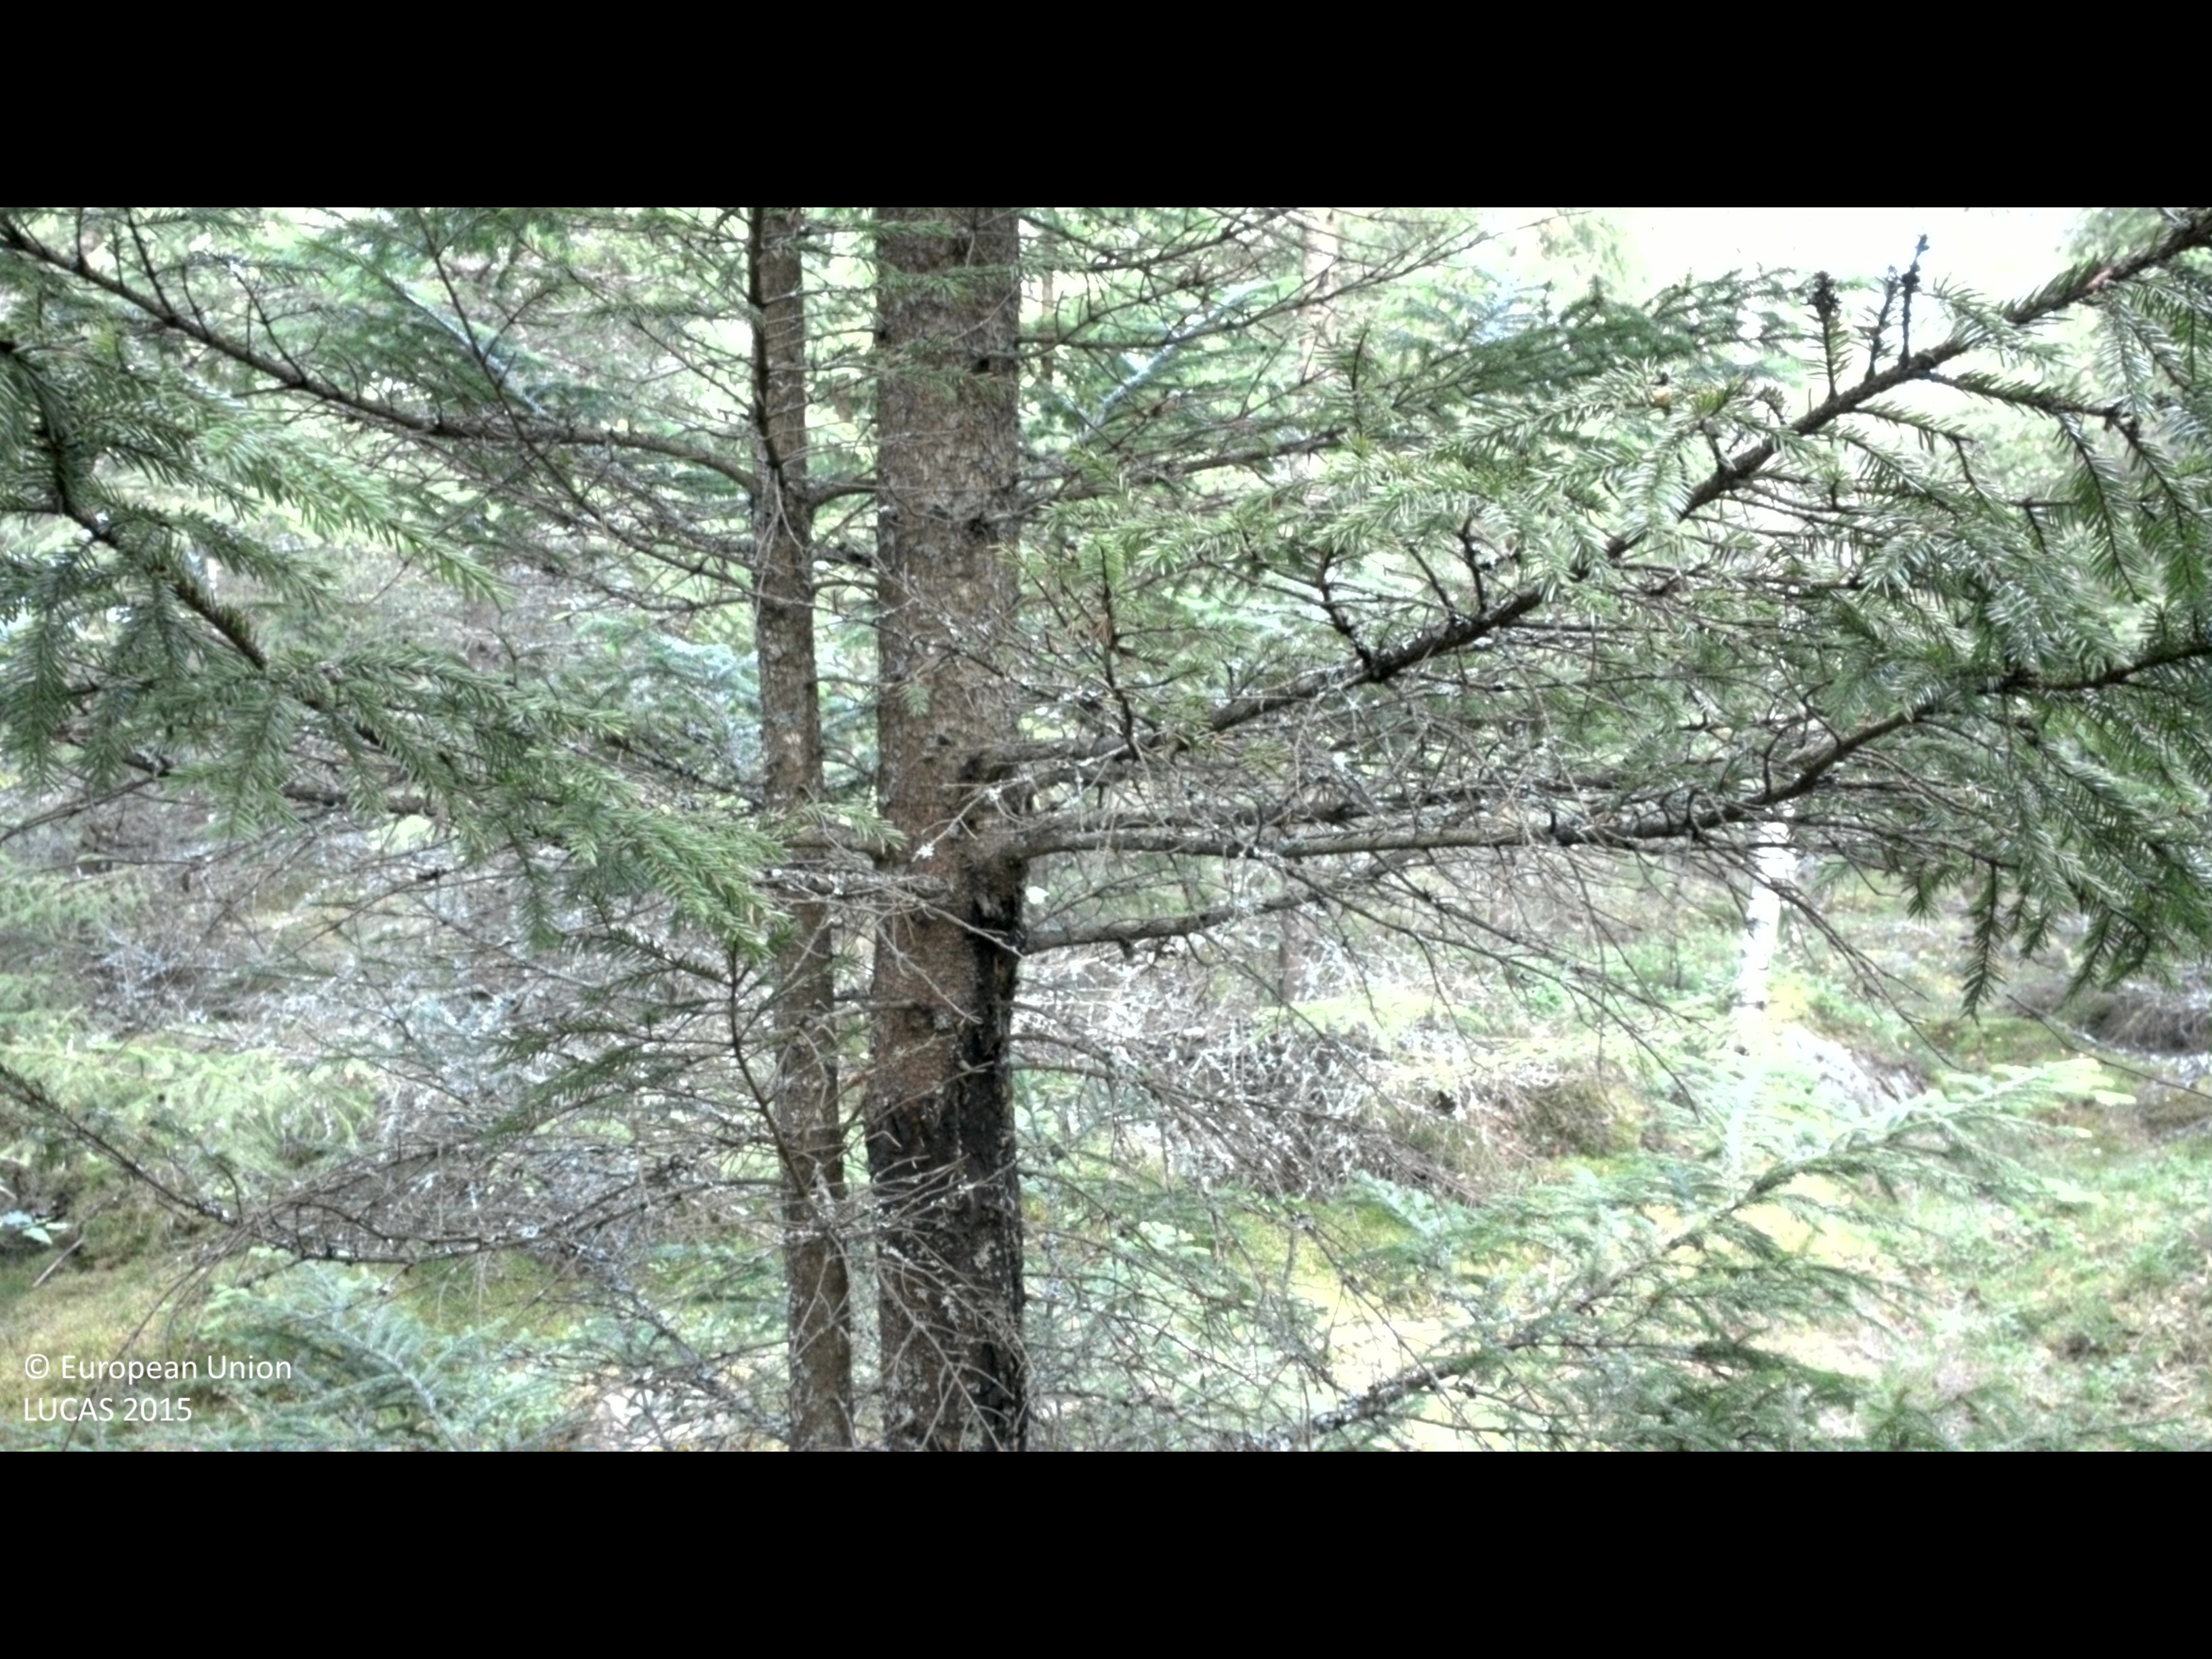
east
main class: Woodland
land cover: Spruce dominated mixed woodland
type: boreal forest
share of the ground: > 75 %
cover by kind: coniferous forest trees 60 %, broadleaved forest trees 20 %, shrubs 10 %, lichens and mosses 10 %
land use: Forestry
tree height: > 5 m
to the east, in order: Spruce dominated mixed woodland
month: August
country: SE
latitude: 56.6933
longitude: 14.2587
